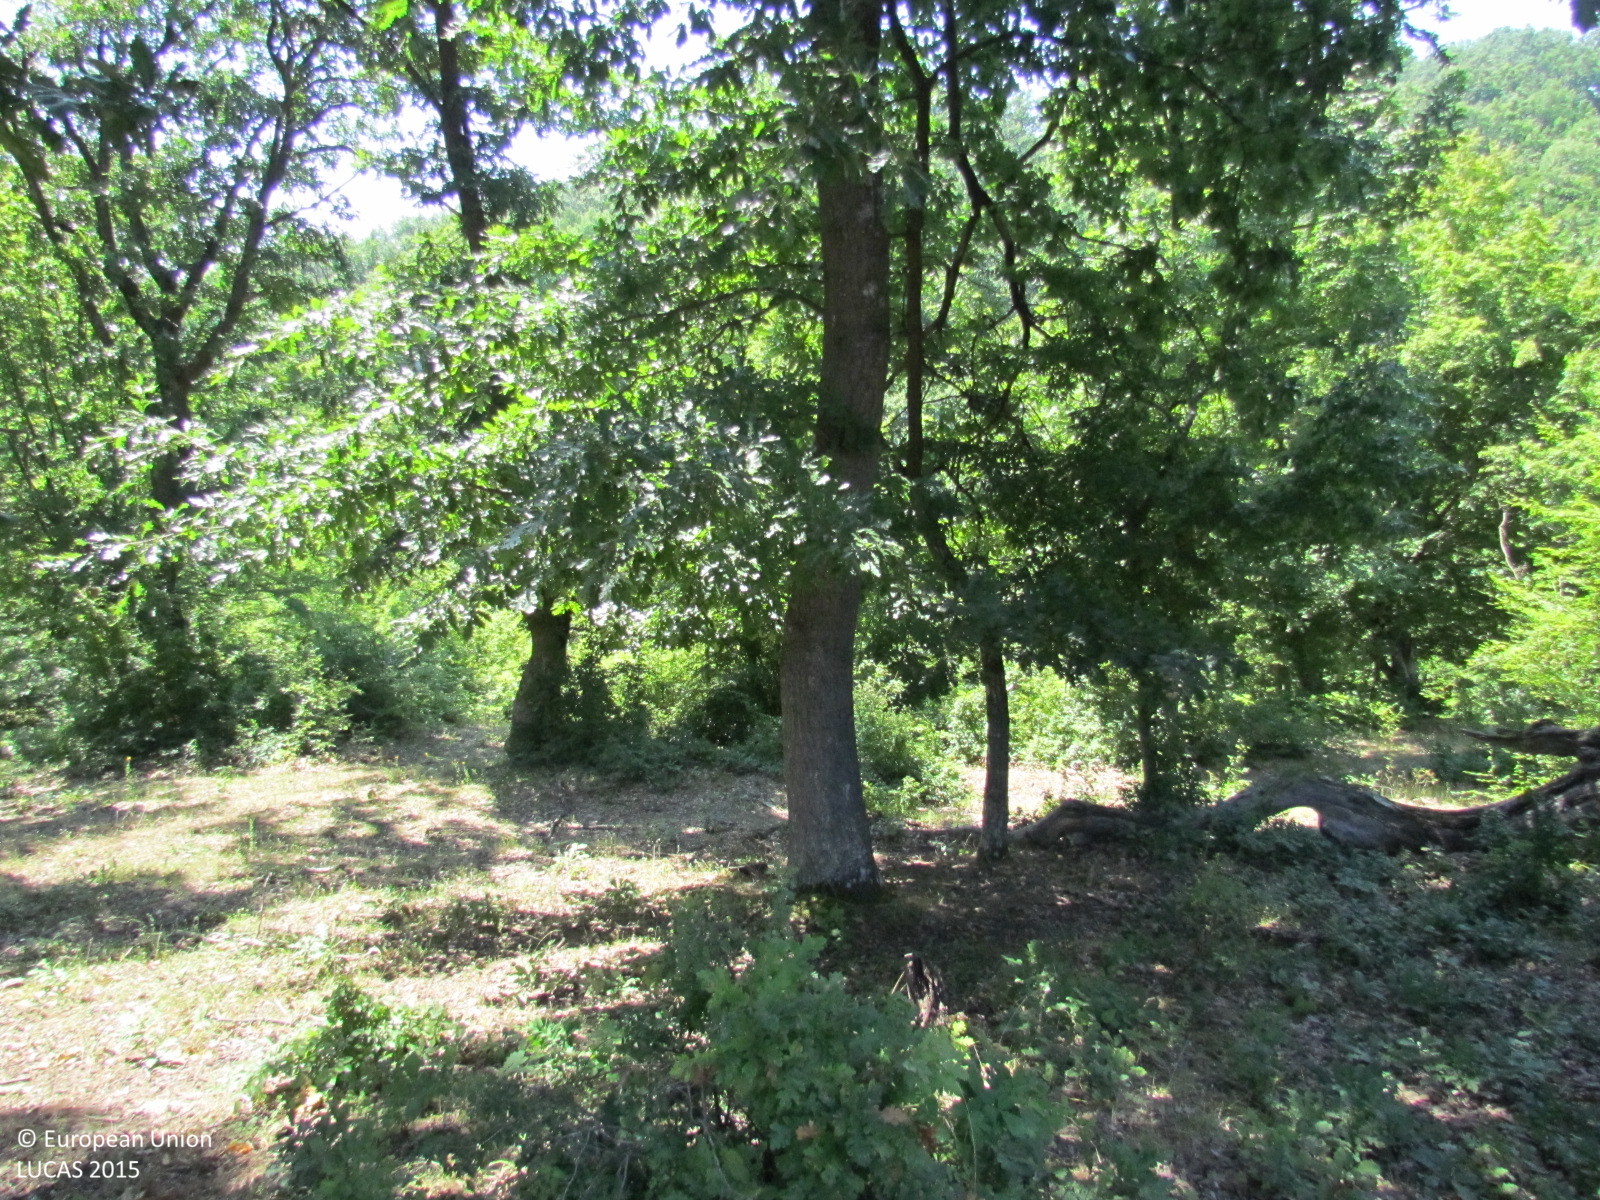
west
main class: Grassland
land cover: Grassland without tree/shrub cover
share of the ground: > 75 %
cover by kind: herbaceous plants 100 %
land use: Agriculture (excluding fallow land and kitchen gardens)
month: July
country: BG
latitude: 42.8423
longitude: 27.4339
